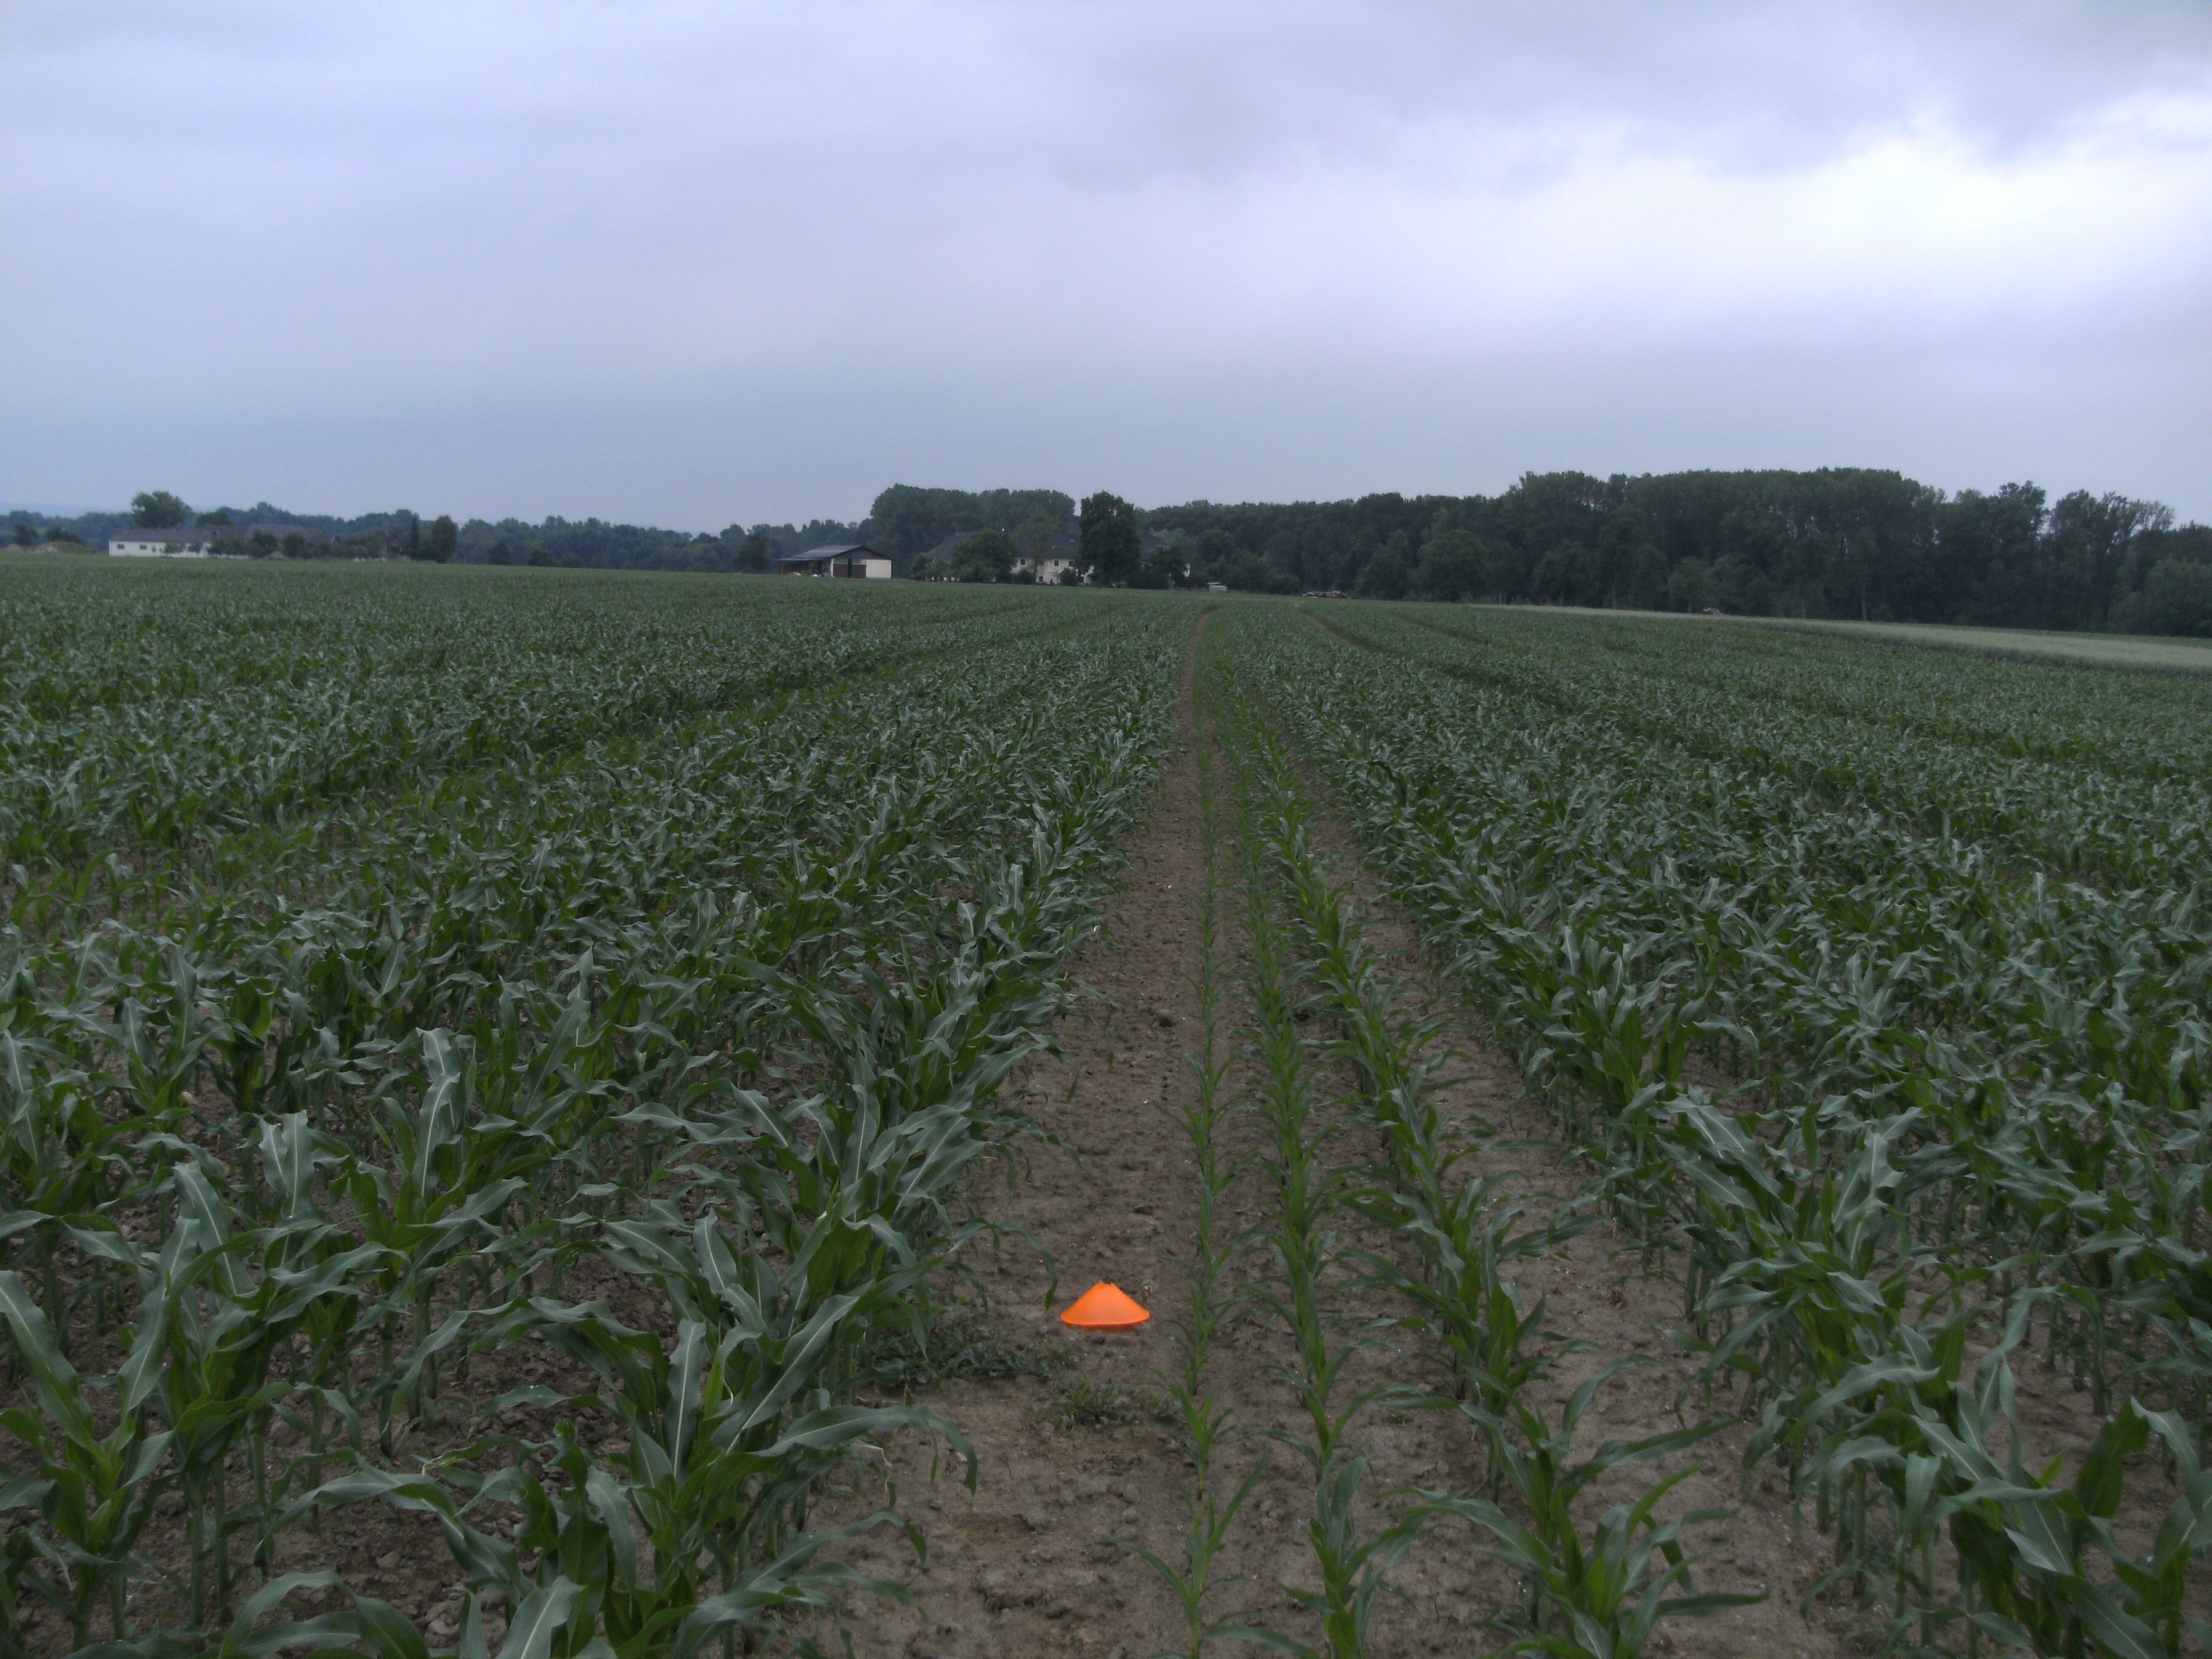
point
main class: Cropland
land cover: Maize
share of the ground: 50 - 75 %
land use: Agriculture (excluding fallow land and kitchen gardens)
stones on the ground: < 10 %
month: June
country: AT
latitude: 48.3479
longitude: 14.0344
